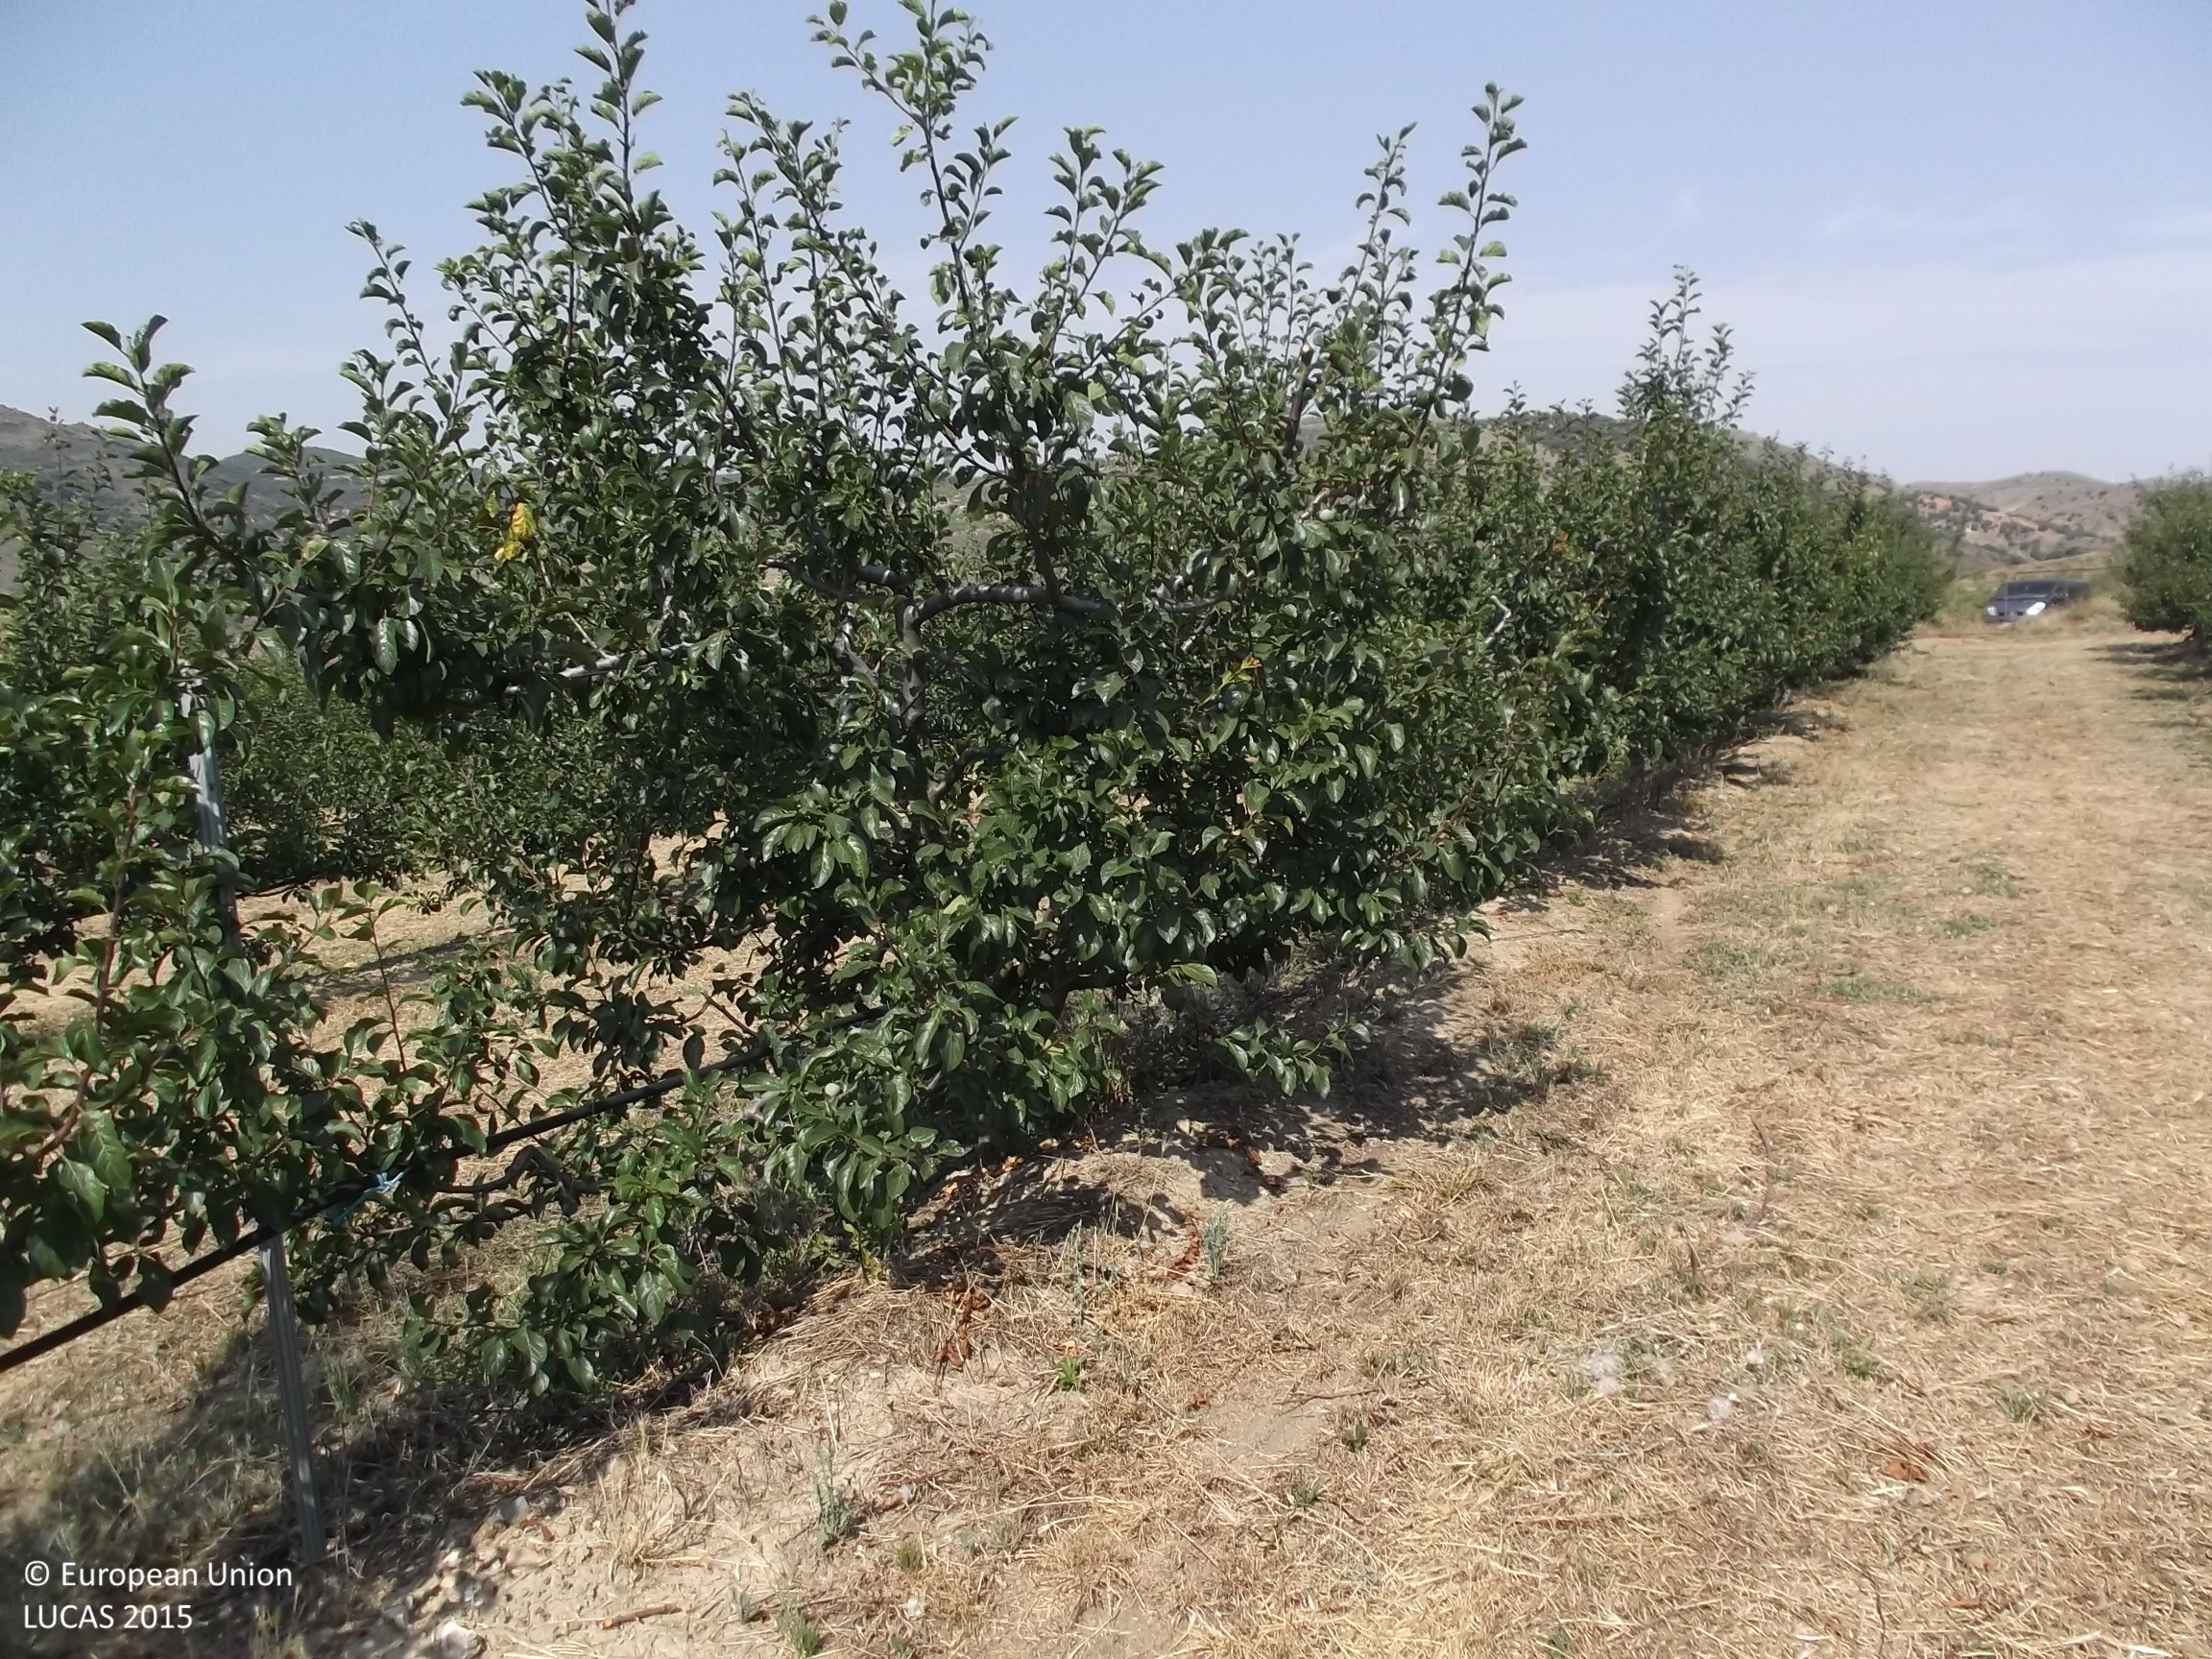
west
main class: Cropland
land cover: Other fruit trees and berries
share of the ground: 25 - 50 %
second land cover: Other bare soil
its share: > 75 %
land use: Agriculture (excluding fallow land and kitchen gardens)
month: July
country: ES
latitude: 42.1088
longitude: -2.0944
